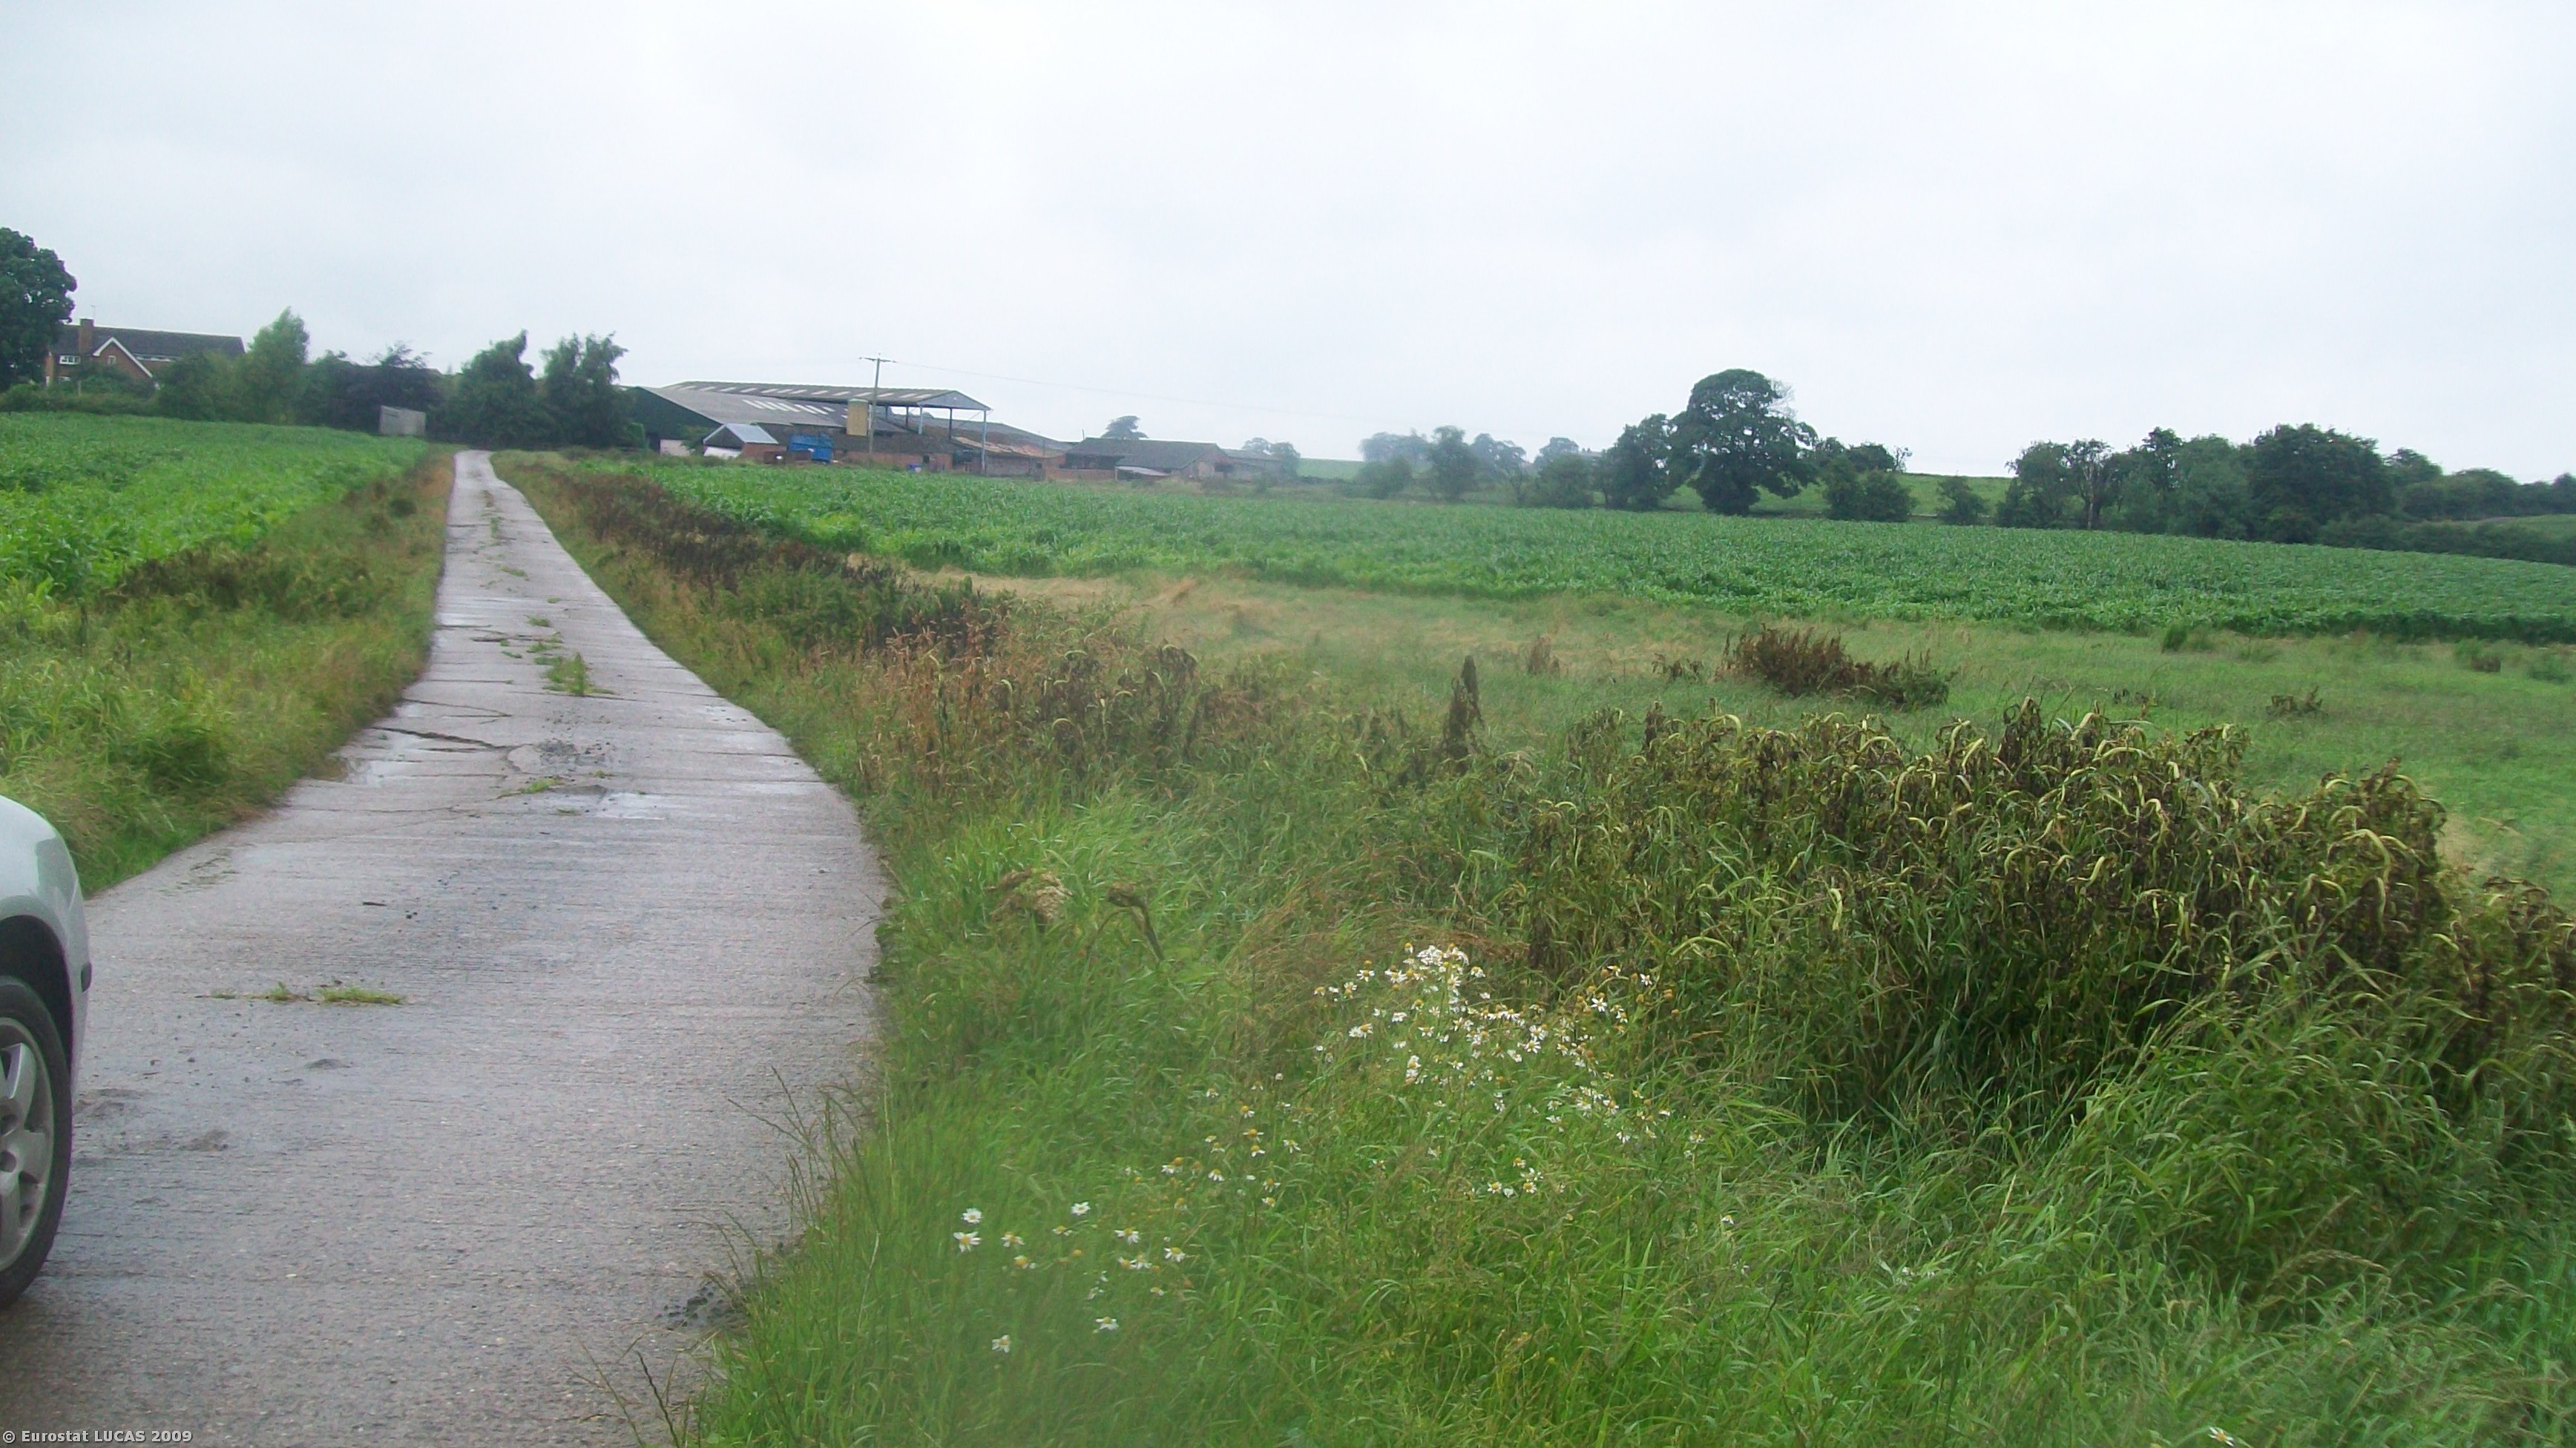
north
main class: Cropland
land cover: Maize
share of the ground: > 75 %
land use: Agriculture (excluding fallow land and kitchen gardens)
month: July
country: GB
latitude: 52.9717
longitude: -2.6513
